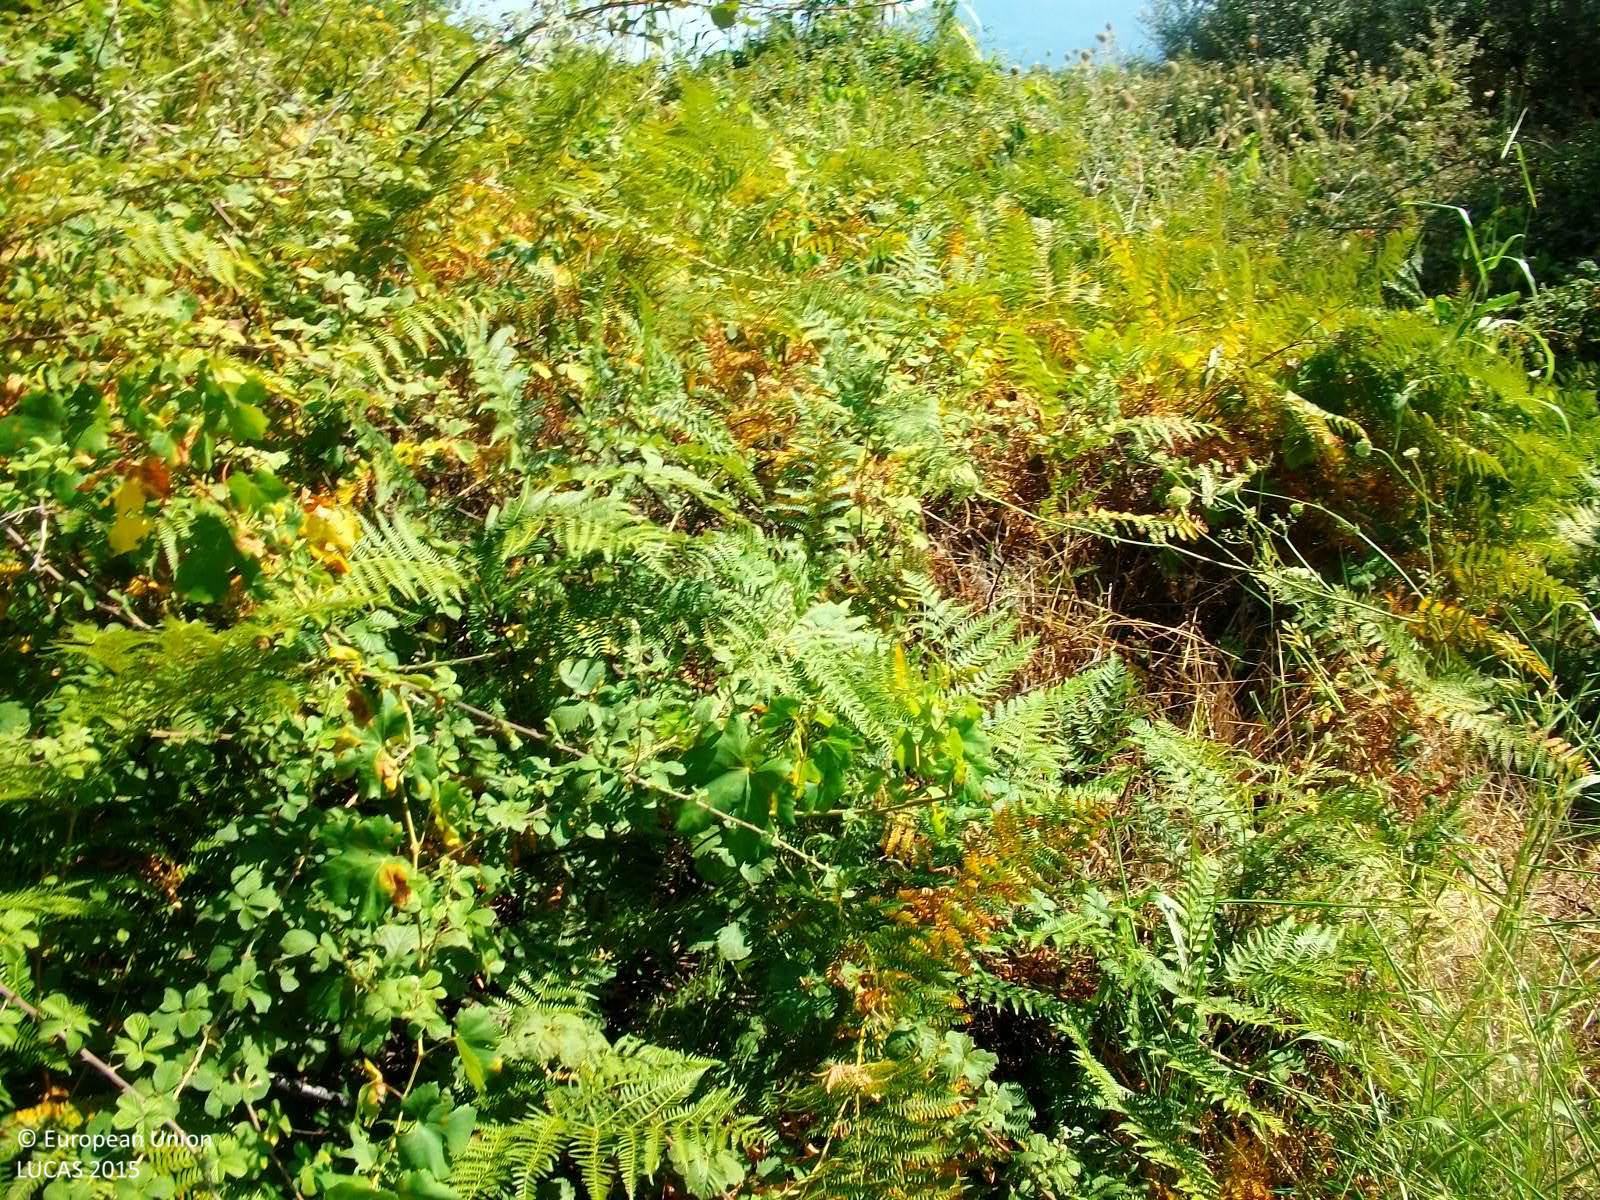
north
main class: Shrubland
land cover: Shrubland without tree cover
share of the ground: > 75 %
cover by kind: shrubs 100 %
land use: Abandoned areas
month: July
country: GR
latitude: 37.0365
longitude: 21.8805
